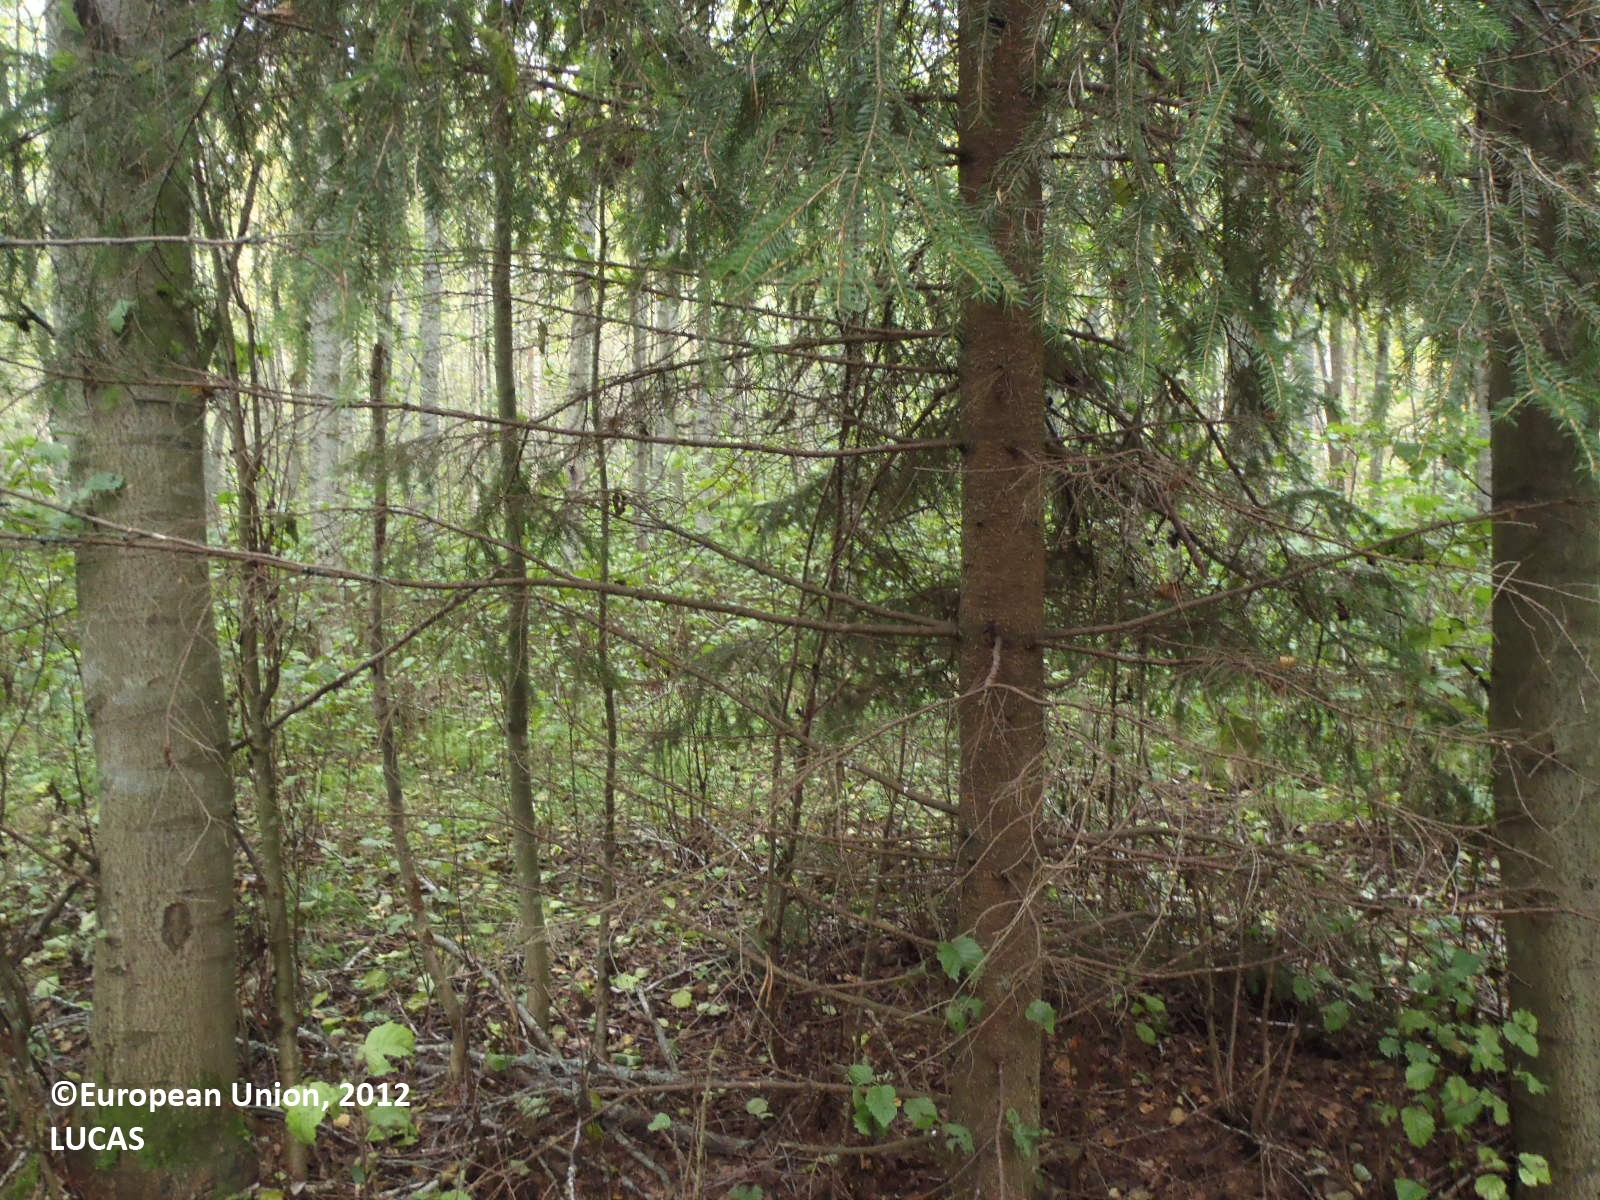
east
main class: Woodland
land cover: Pine dominated mixed woodland
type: boreal forest
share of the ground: > 75 %
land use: Forestry
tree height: > 5 m
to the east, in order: Pine dominated mixed woodland; Ditches and canals; Broadleaved woodland; Ditches and canals; Broadleaved woodland; Ditches and canals; Broadleaved woodland; Other mixed woodland; Ditches and canals; Pine dominated mixed woodland; Ditches and canals; Spruce dominated coniferous woodland; Pine dominated coniferous woodland
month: September
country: FI
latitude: 60.7439
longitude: 22.8223
